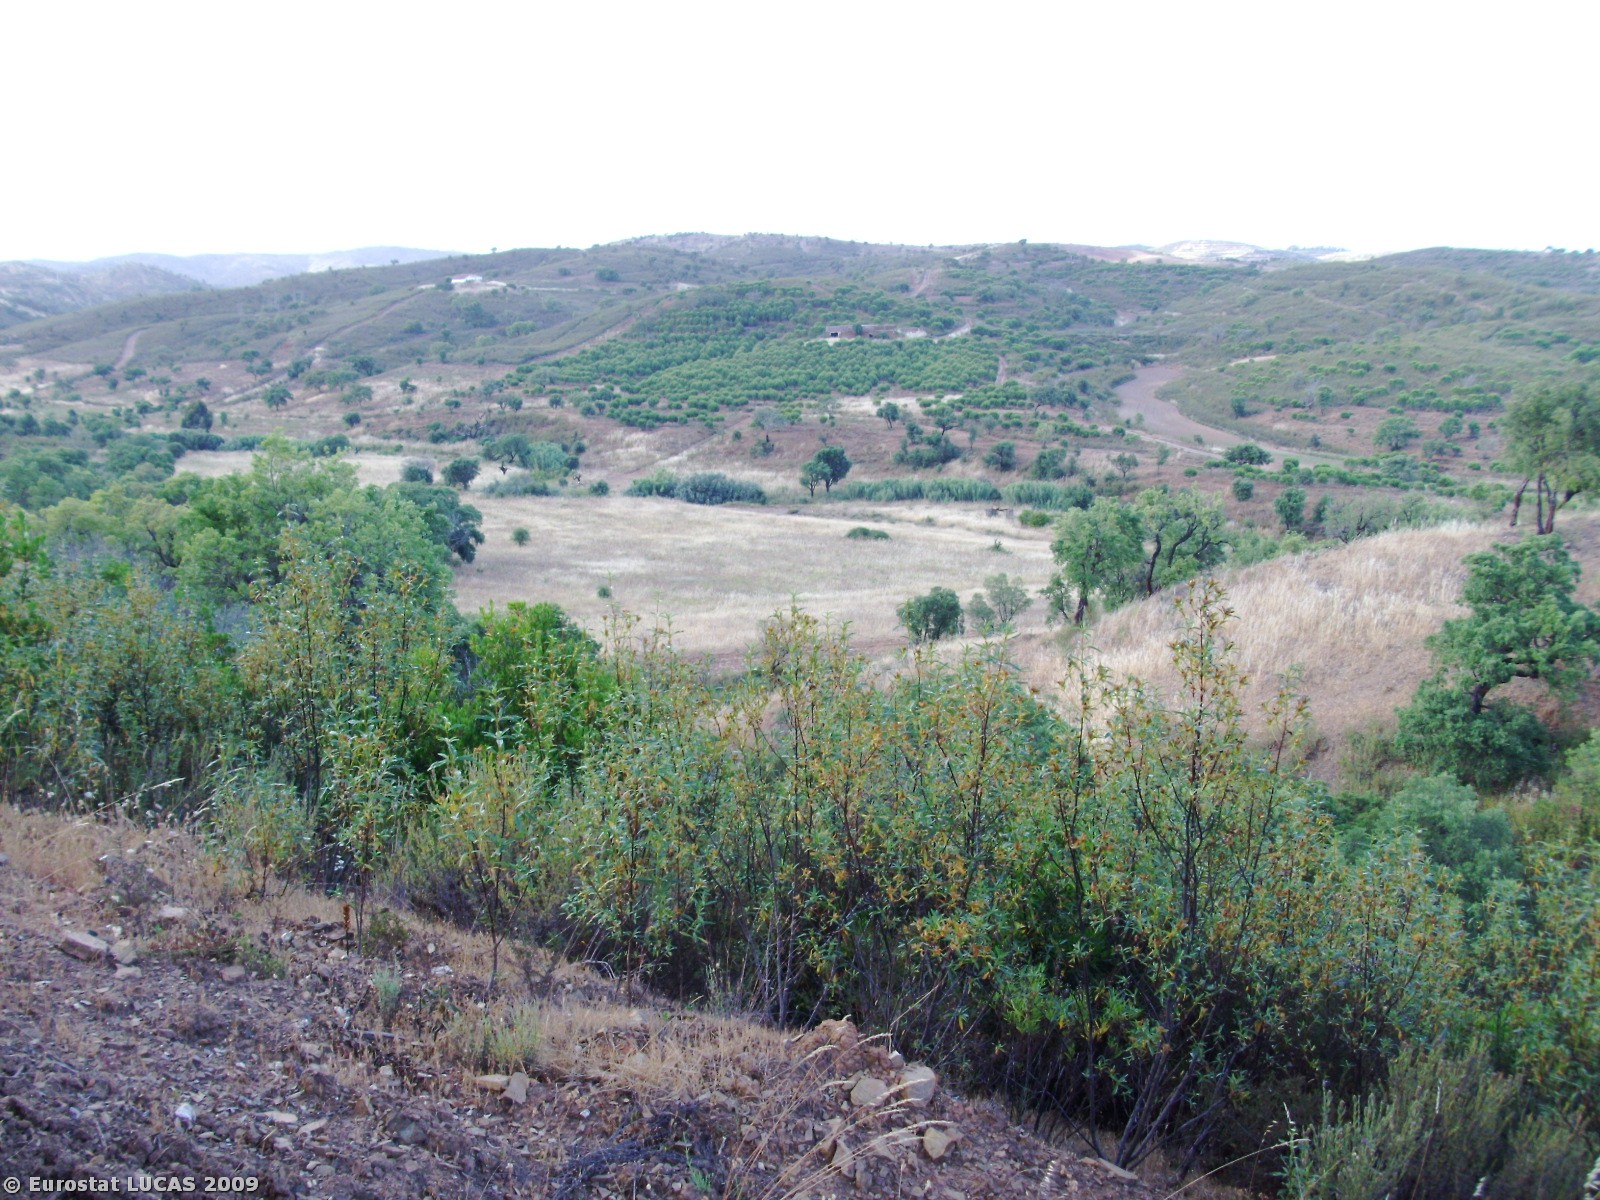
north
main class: Woodland
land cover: Broadleaved woodland
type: broadleaved evergreen forest
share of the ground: 10 - 25 %
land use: Forestry
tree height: > 5 m
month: June
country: PT
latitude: 37.1831
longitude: -8.7412
